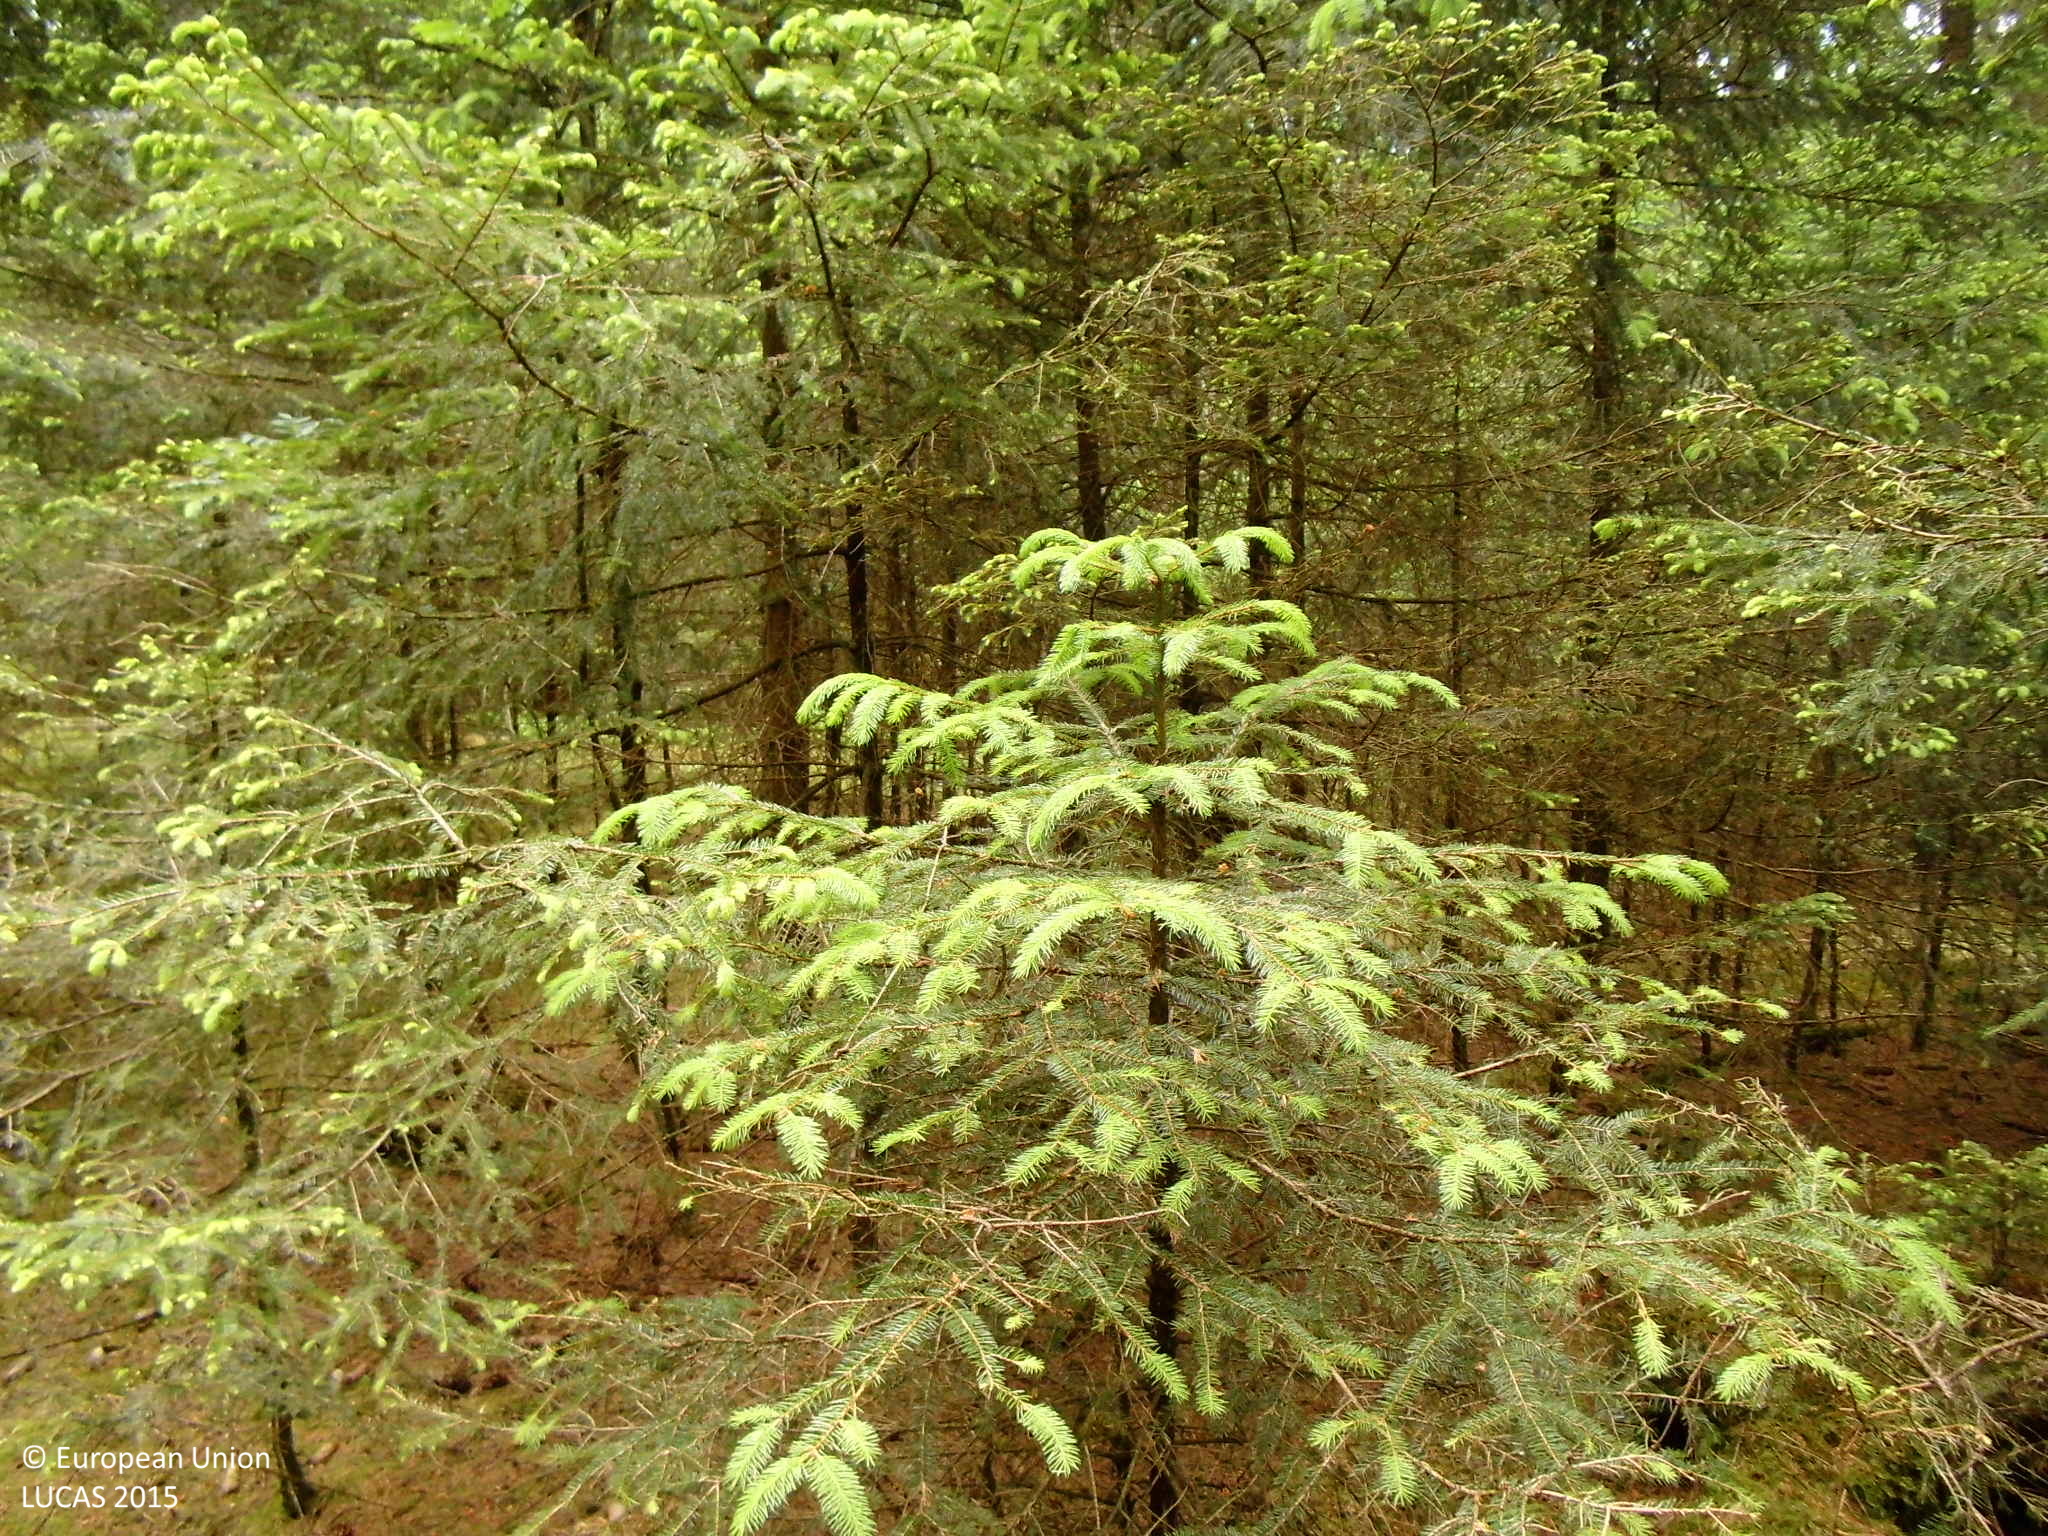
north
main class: Woodland
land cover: Spruce dominated coniferous woodland
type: hemiboreal forest and nemoral coniferous forest and mixed broadleaved-coniferous forest
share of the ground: > 75 %
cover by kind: coniferous forest trees 75 %, lichens and mosses 15 %, broadleaved forest trees 5 %, herbaceous plants 5 %
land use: Forestry
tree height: > 5 m
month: June
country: DE
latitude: 51.0478
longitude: 7.9891
